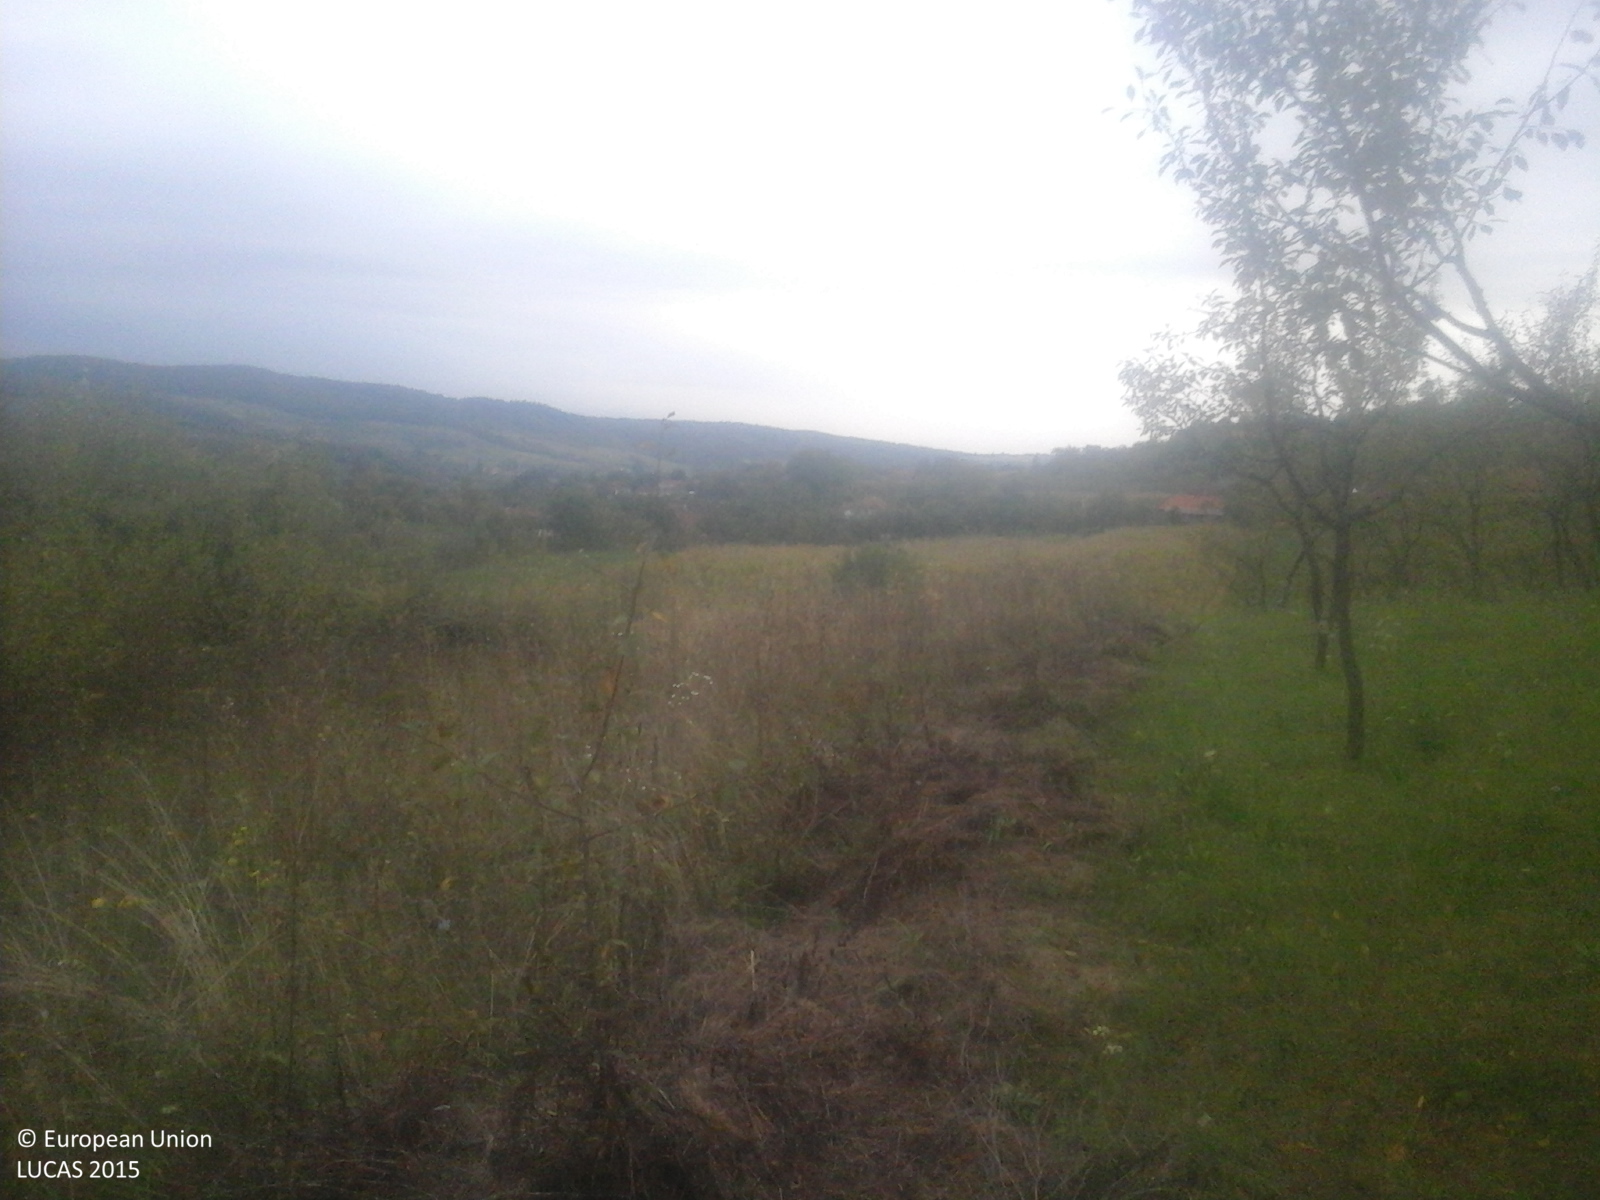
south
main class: Cropland
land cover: Apple fruit
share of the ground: > 75 %
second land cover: Grassland without tree/shrub cover
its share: > 75 %
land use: Agriculture (excluding fallow land and kitchen gardens)
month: September
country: RO
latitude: 46.7886
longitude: 22.2717
